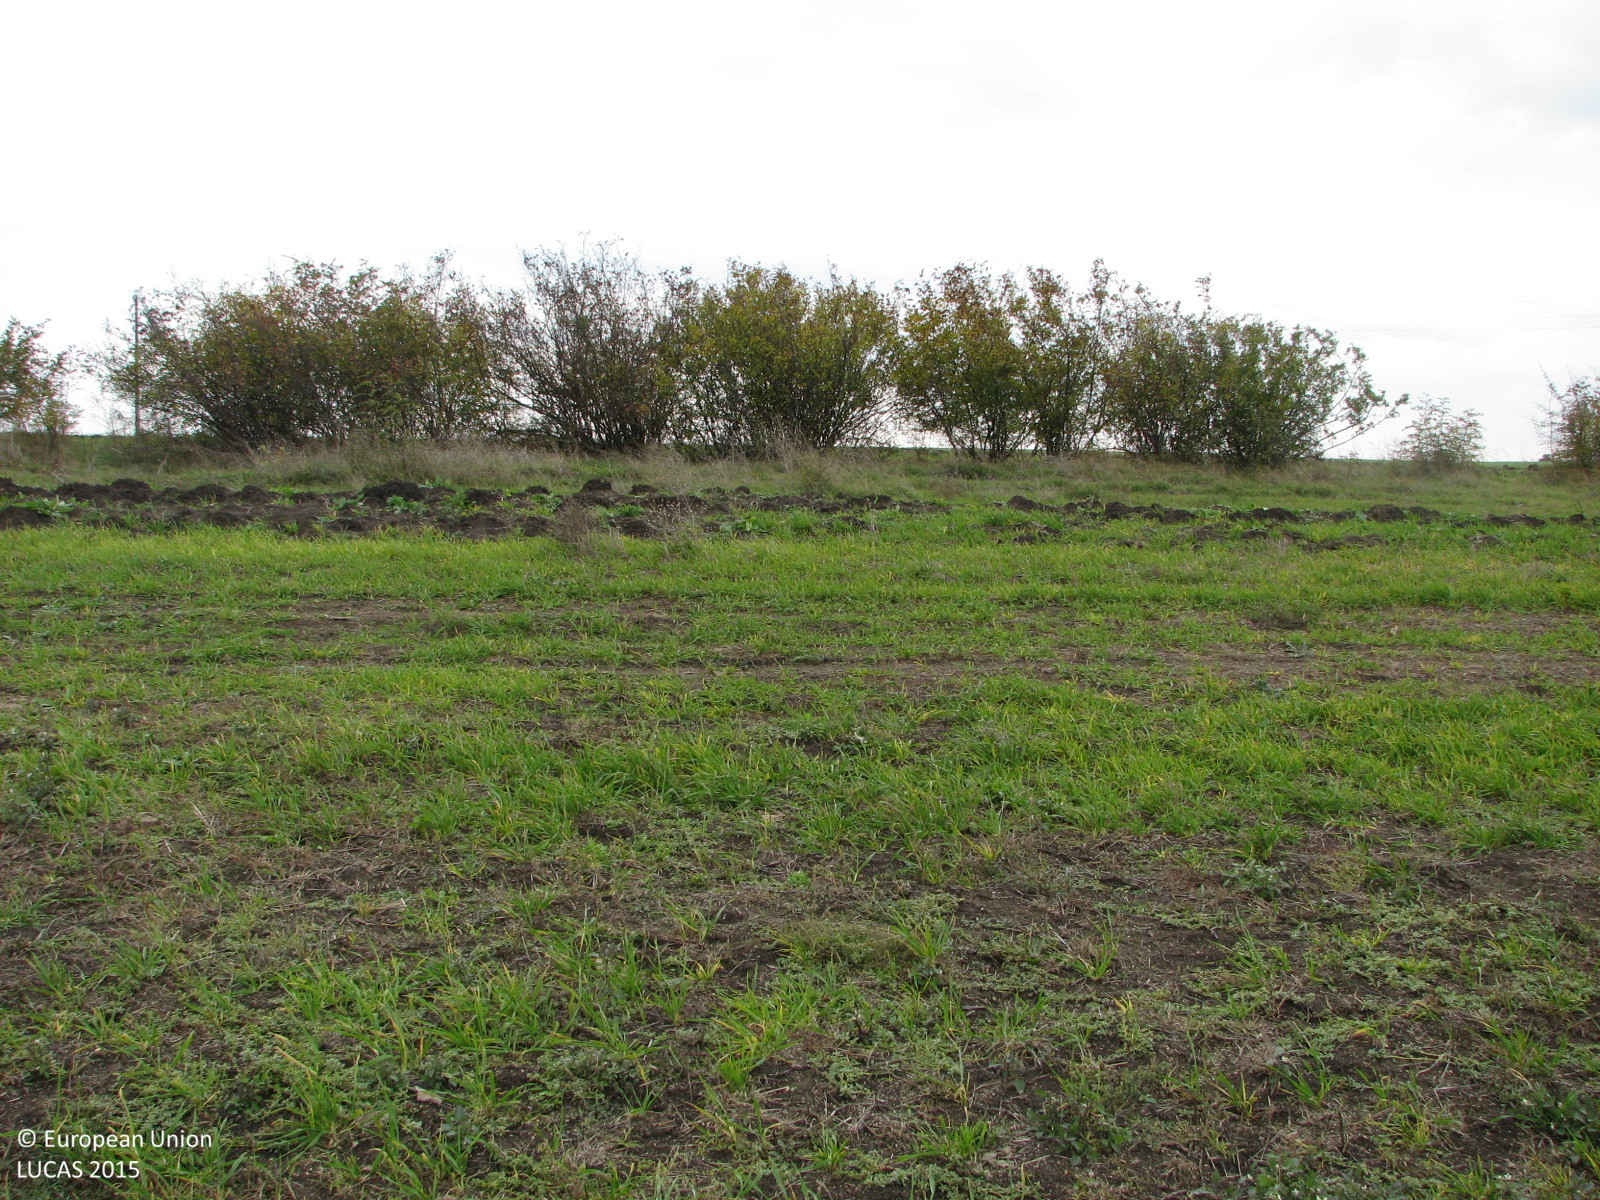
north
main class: Grassland
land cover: Spontaneously vegetated surfaces
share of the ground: > 75 %
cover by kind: herbaceous plants 80 %, unconsolidated bare surface 20 %
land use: Agriculture (excluding fallow land and kitchen gardens)
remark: Harvested field
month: October
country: BG
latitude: 42.2224
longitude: 26.7530
